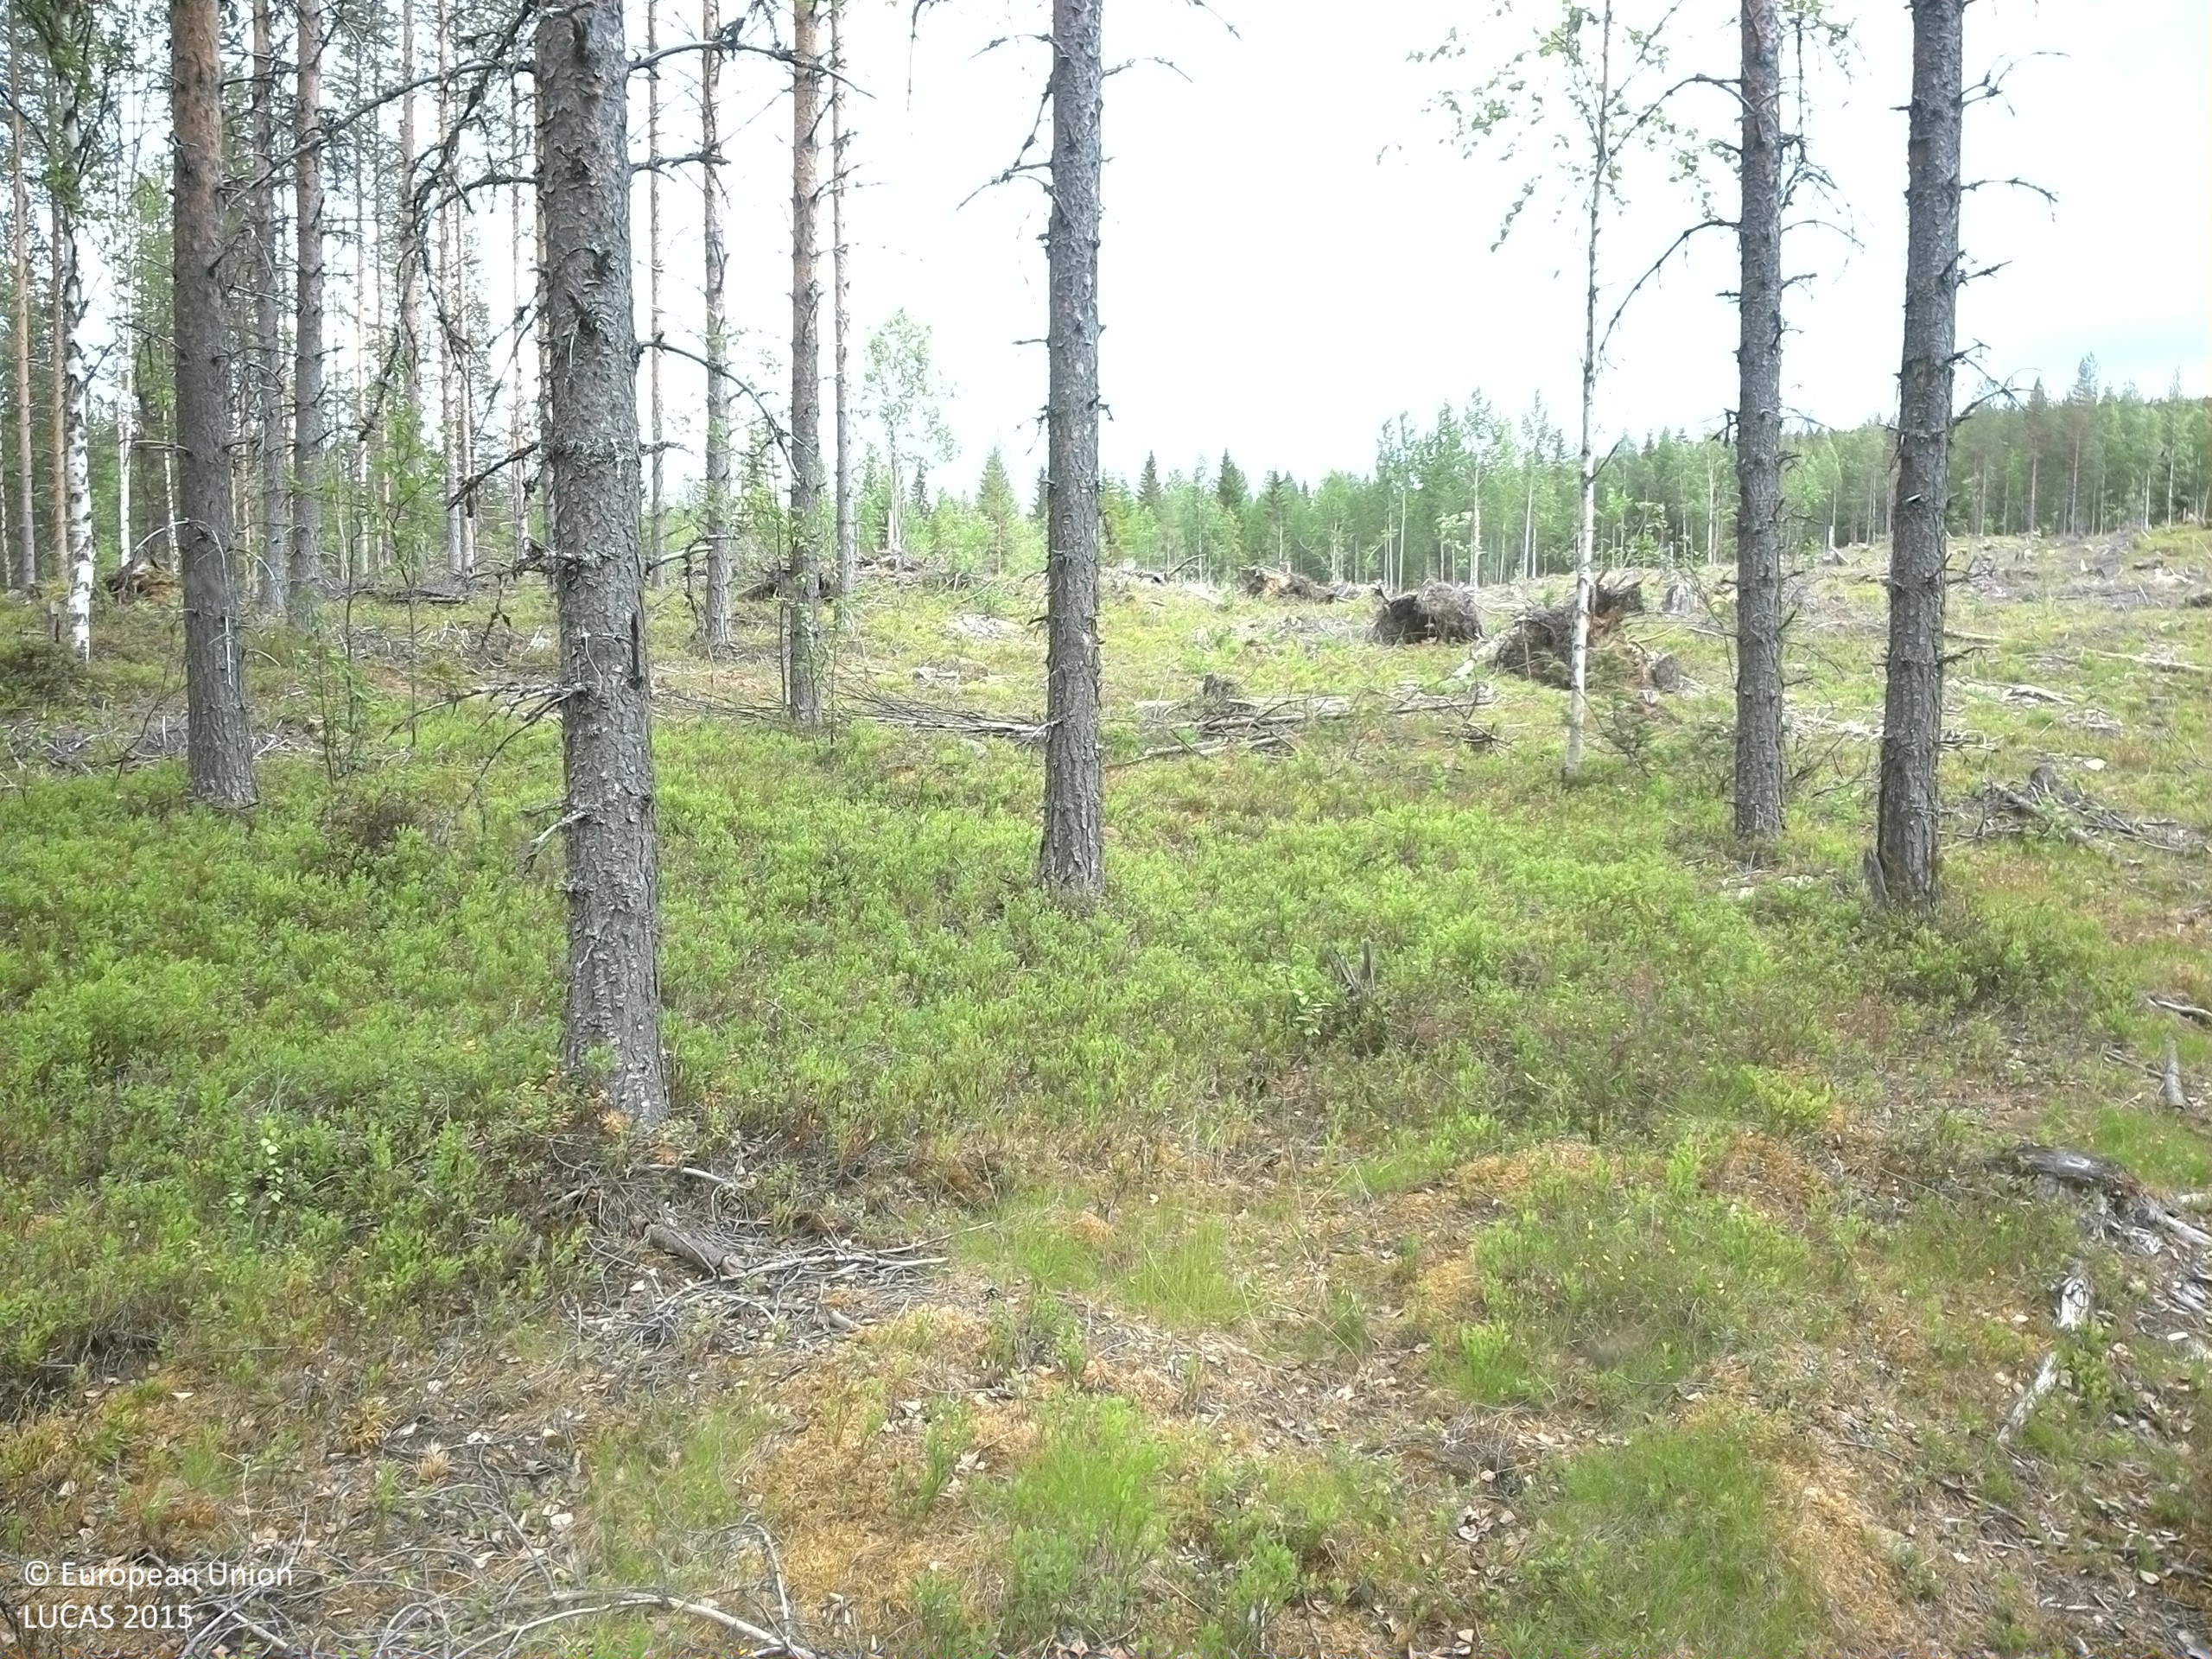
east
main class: Woodland
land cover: Pine dominated mixed woodland
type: boreal forest
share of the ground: 25 - 50 %
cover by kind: coniferous forest trees 35 %, shrubs 30 %, broadleaved forest trees 15 %, lichens and mosses 10 %, herbaceous plants 5 %, unconsolidated bare surface 5 %
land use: Forestry
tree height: > 5 m
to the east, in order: Pine dominated mixed woodland; Shrubland without tree cover; Tracks; Shrubland without tree cover; Pine dominated mixed woodland; Shrubland with sparse tree cover; Tracks; Pine dominated mixed woodland; Spruce dominated mixed woodland
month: July
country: SE
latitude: 64.1986
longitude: 16.7854
